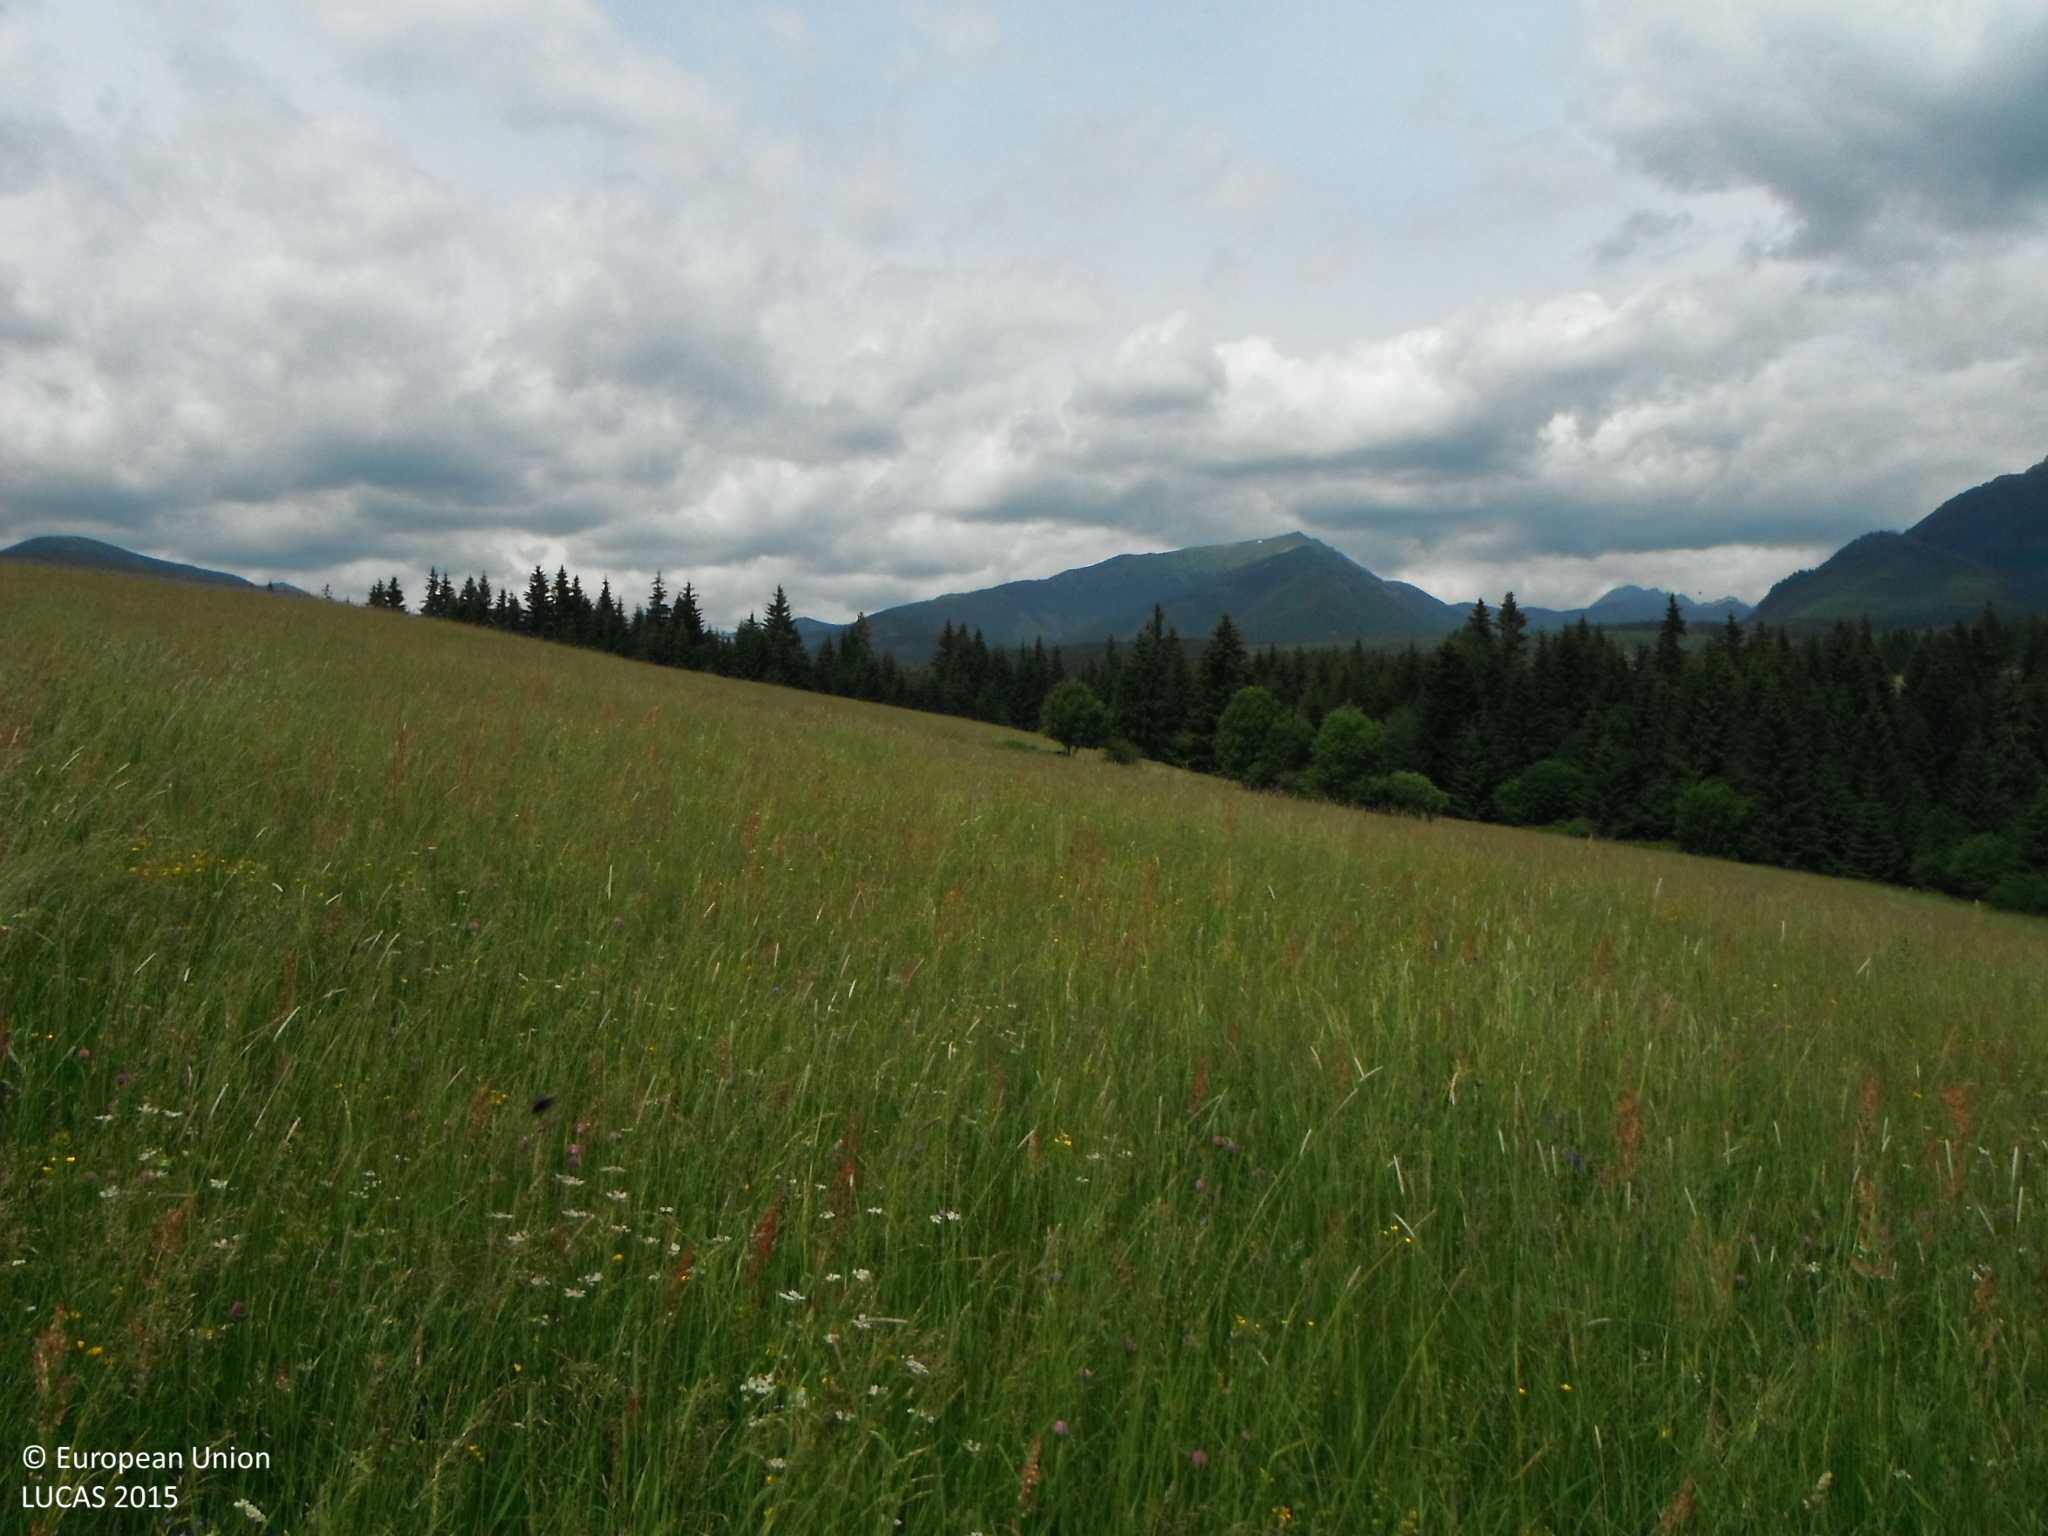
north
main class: Grassland
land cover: Grassland without tree/shrub cover
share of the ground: > 75 %
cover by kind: herbaceous plants 100 %
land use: Agriculture (excluding fallow land and kitchen gardens)
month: June
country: SK
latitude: 49.1149
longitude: 19.9357
